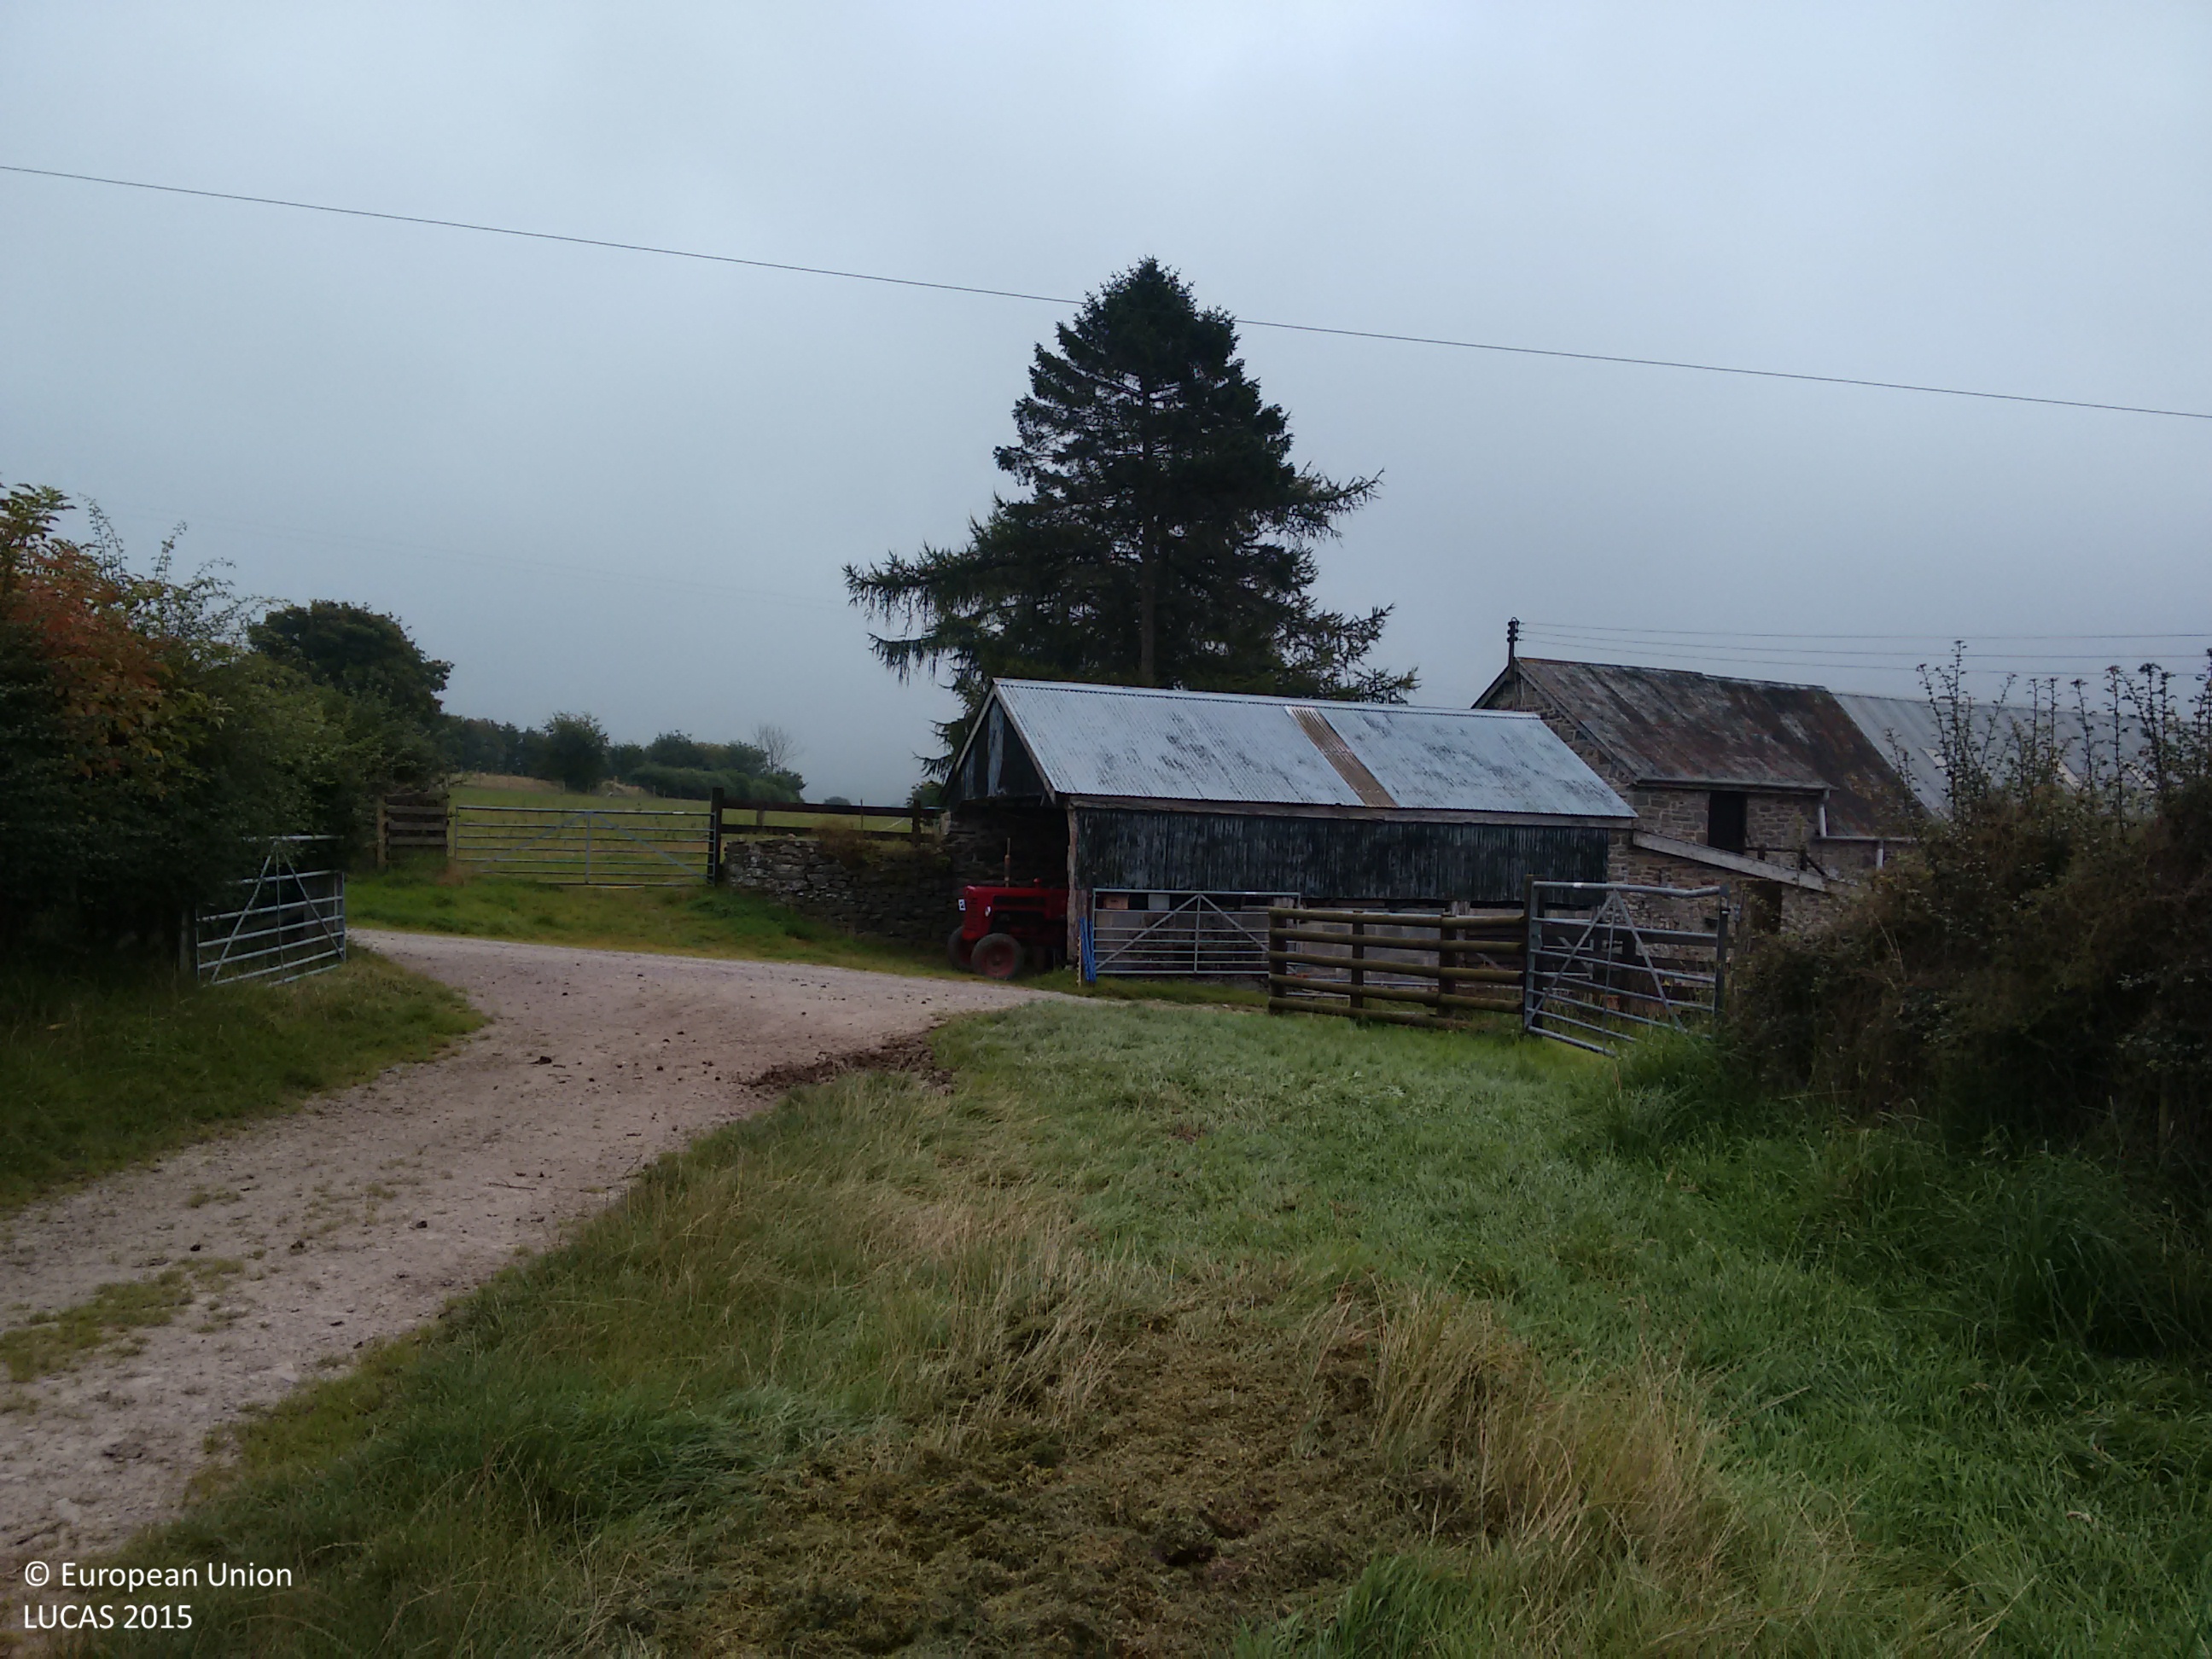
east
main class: Grassland
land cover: Grassland with sparse tree/shrub cover
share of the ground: > 75 %
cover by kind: herbaceous plants 95 %, coniferous forest trees 5 %
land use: Agriculture (excluding fallow land and kitchen gardens)
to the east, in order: Grassland with sparse tree/shrub cover; Artificial constructions in urban areas; Grassland without tree/shrub cover; Electric lines; Grassland without tree/shrub cover; Fences; Managed hedges; Fences; Grassland without tree/shrub cover; Fences; Rivers and streams; Managed hedges; Fences; Grassland without tree/shrub cover
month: September
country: GB
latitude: 52.1062
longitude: -3.2344
